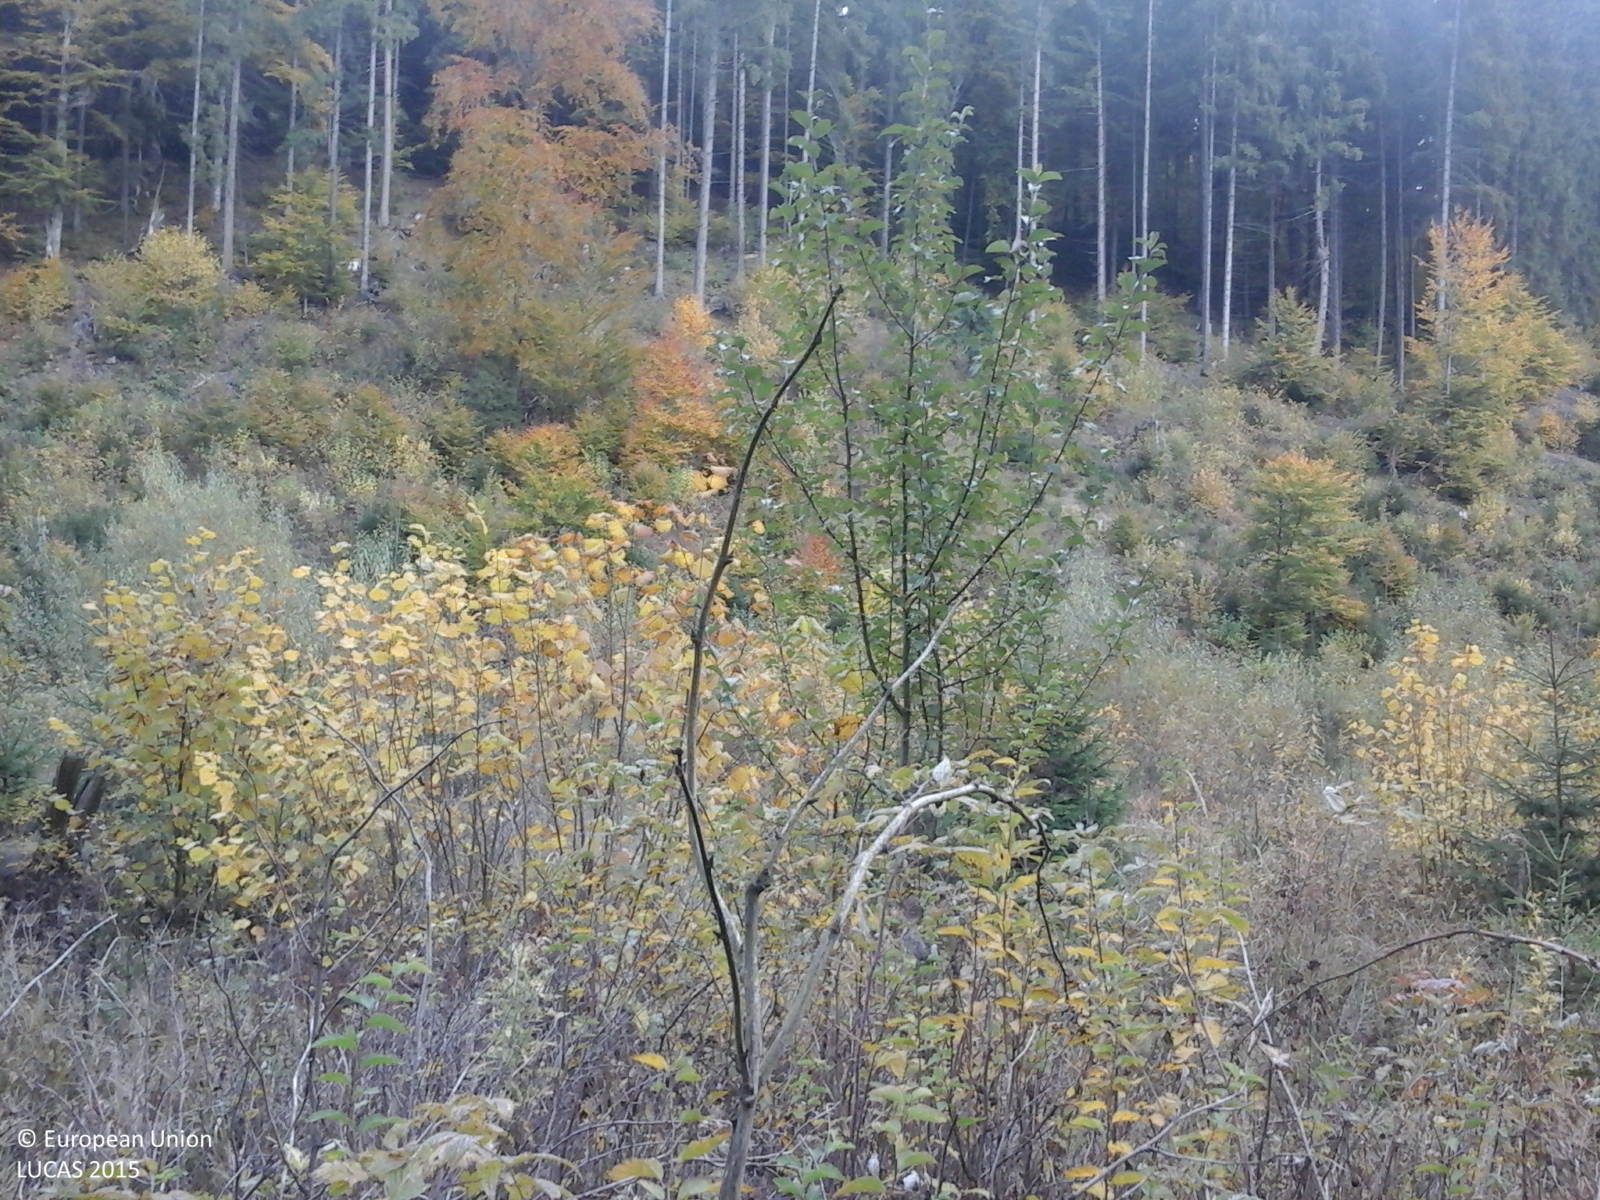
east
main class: Shrubland
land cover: Shrubland with sparse tree cover
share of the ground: > 75 %
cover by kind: shrubs 95 %, broadleaved forest trees 5 %
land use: Semi-natural and natural areas not in use
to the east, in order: Shrubland with sparse tree cover; Rivers and streams; Other mixed woodland; Spruce dominated coniferous woodland; Grassland without tree/shrub cover
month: October
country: RO
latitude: 46.5184
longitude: 25.3428
